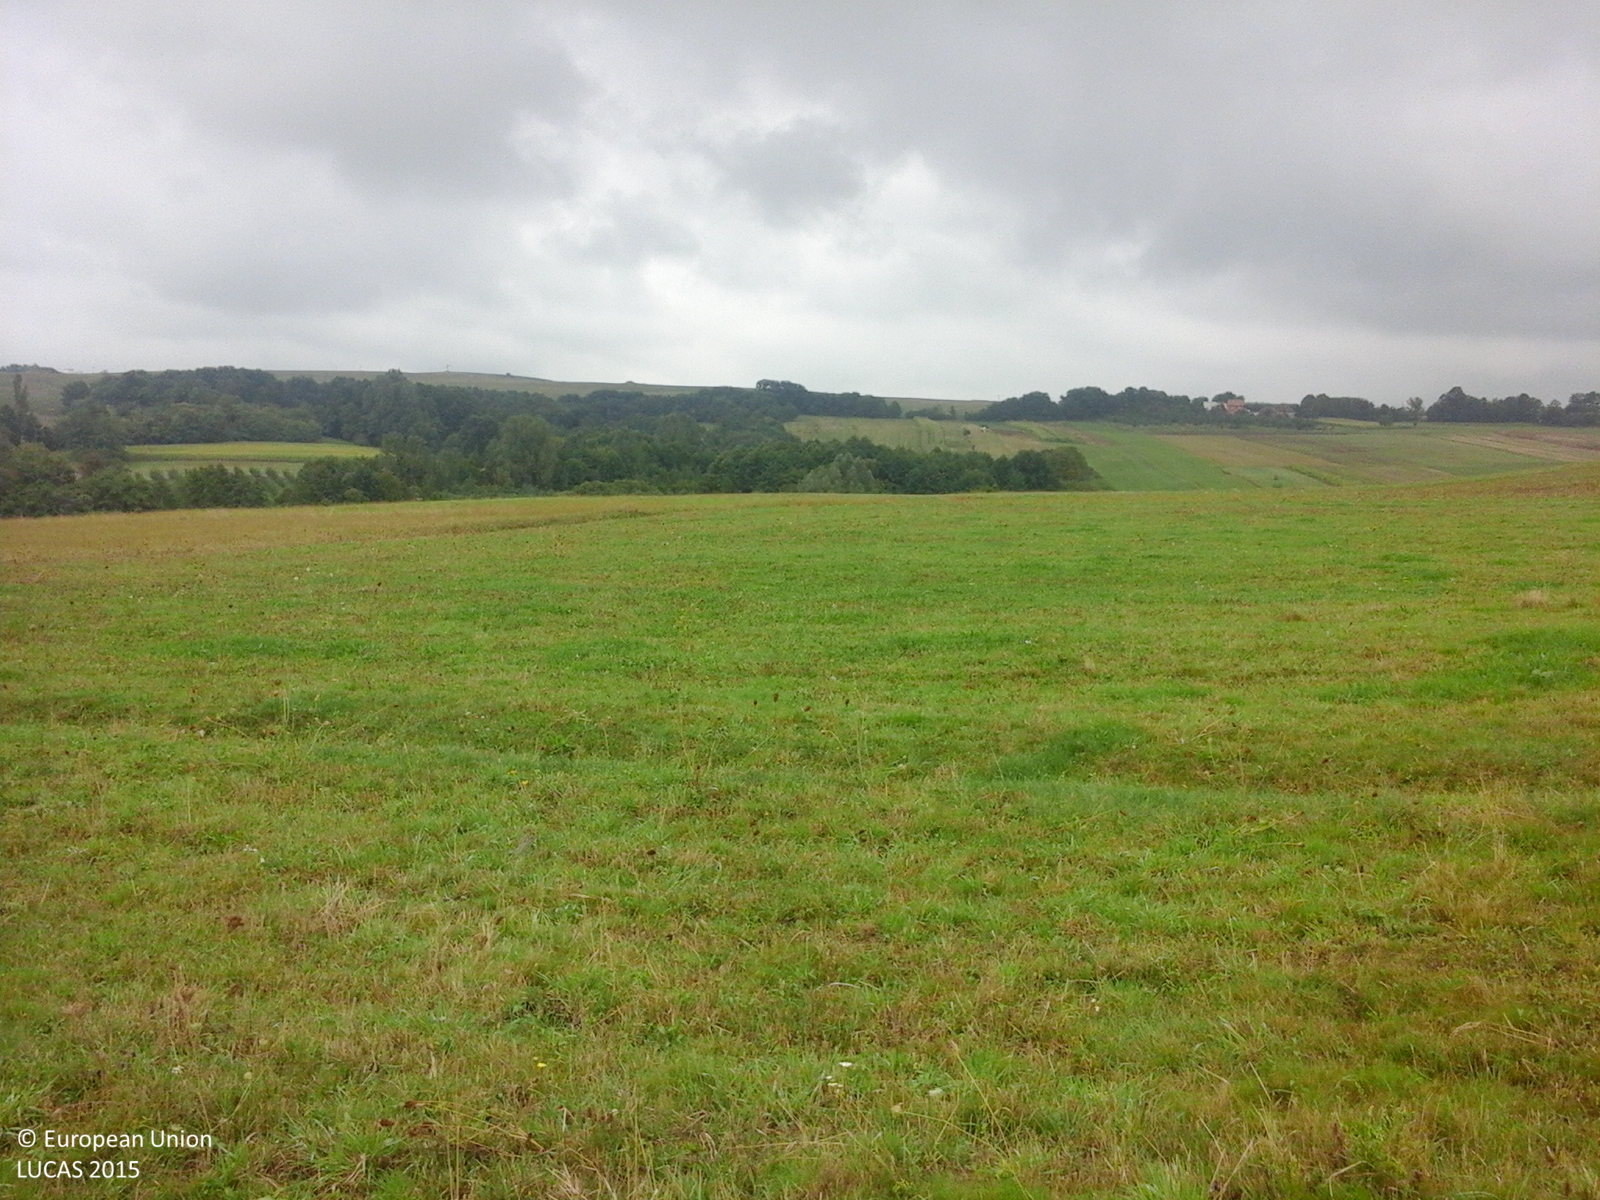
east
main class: Grassland
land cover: Grassland without tree/shrub cover
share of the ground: > 75 %
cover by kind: herbaceous plants 100 %
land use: Agriculture (excluding fallow land and kitchen gardens)
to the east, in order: Grassland without tree/shrub cover; Tracks; Grassland without tree/shrub cover; Common wheat; Maize
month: September
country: RO
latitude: 46.9712
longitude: 22.5817
